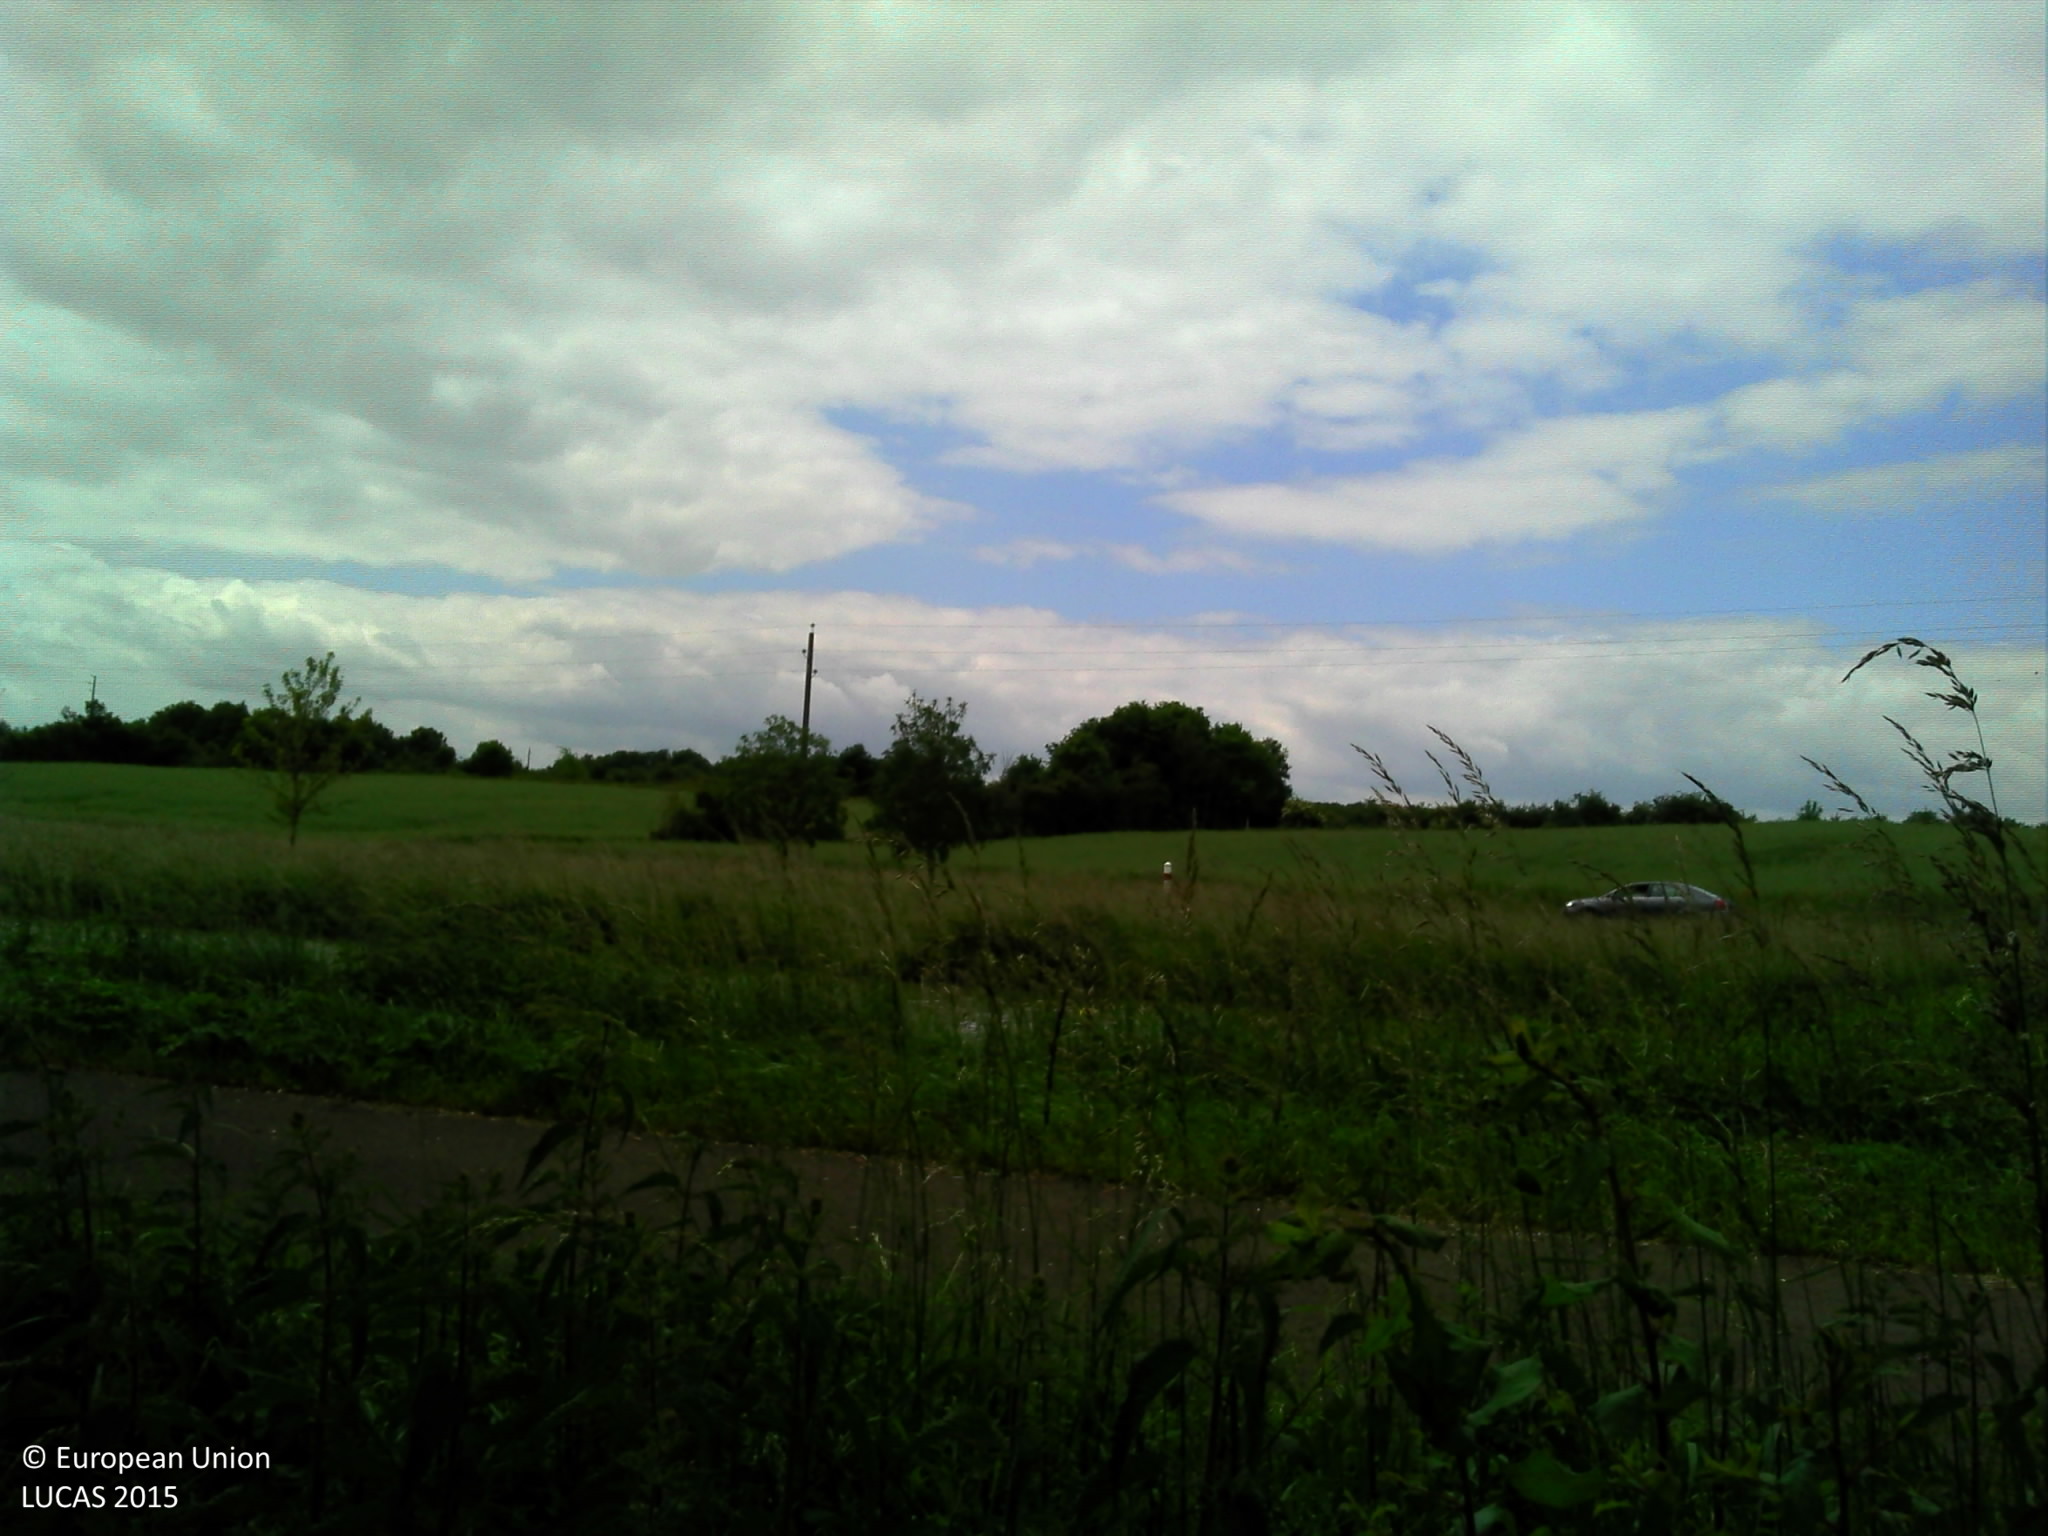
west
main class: Woodland
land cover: Broadleaved woodland
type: boreal forest
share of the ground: > 75 %
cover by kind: broadleaved forest trees 70 %, shrubs 15 %, herbaceous plants 15 %
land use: Semi-natural and natural areas not in use
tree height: > 5 m
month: May
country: FR
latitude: 47.3791
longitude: 2.8816
